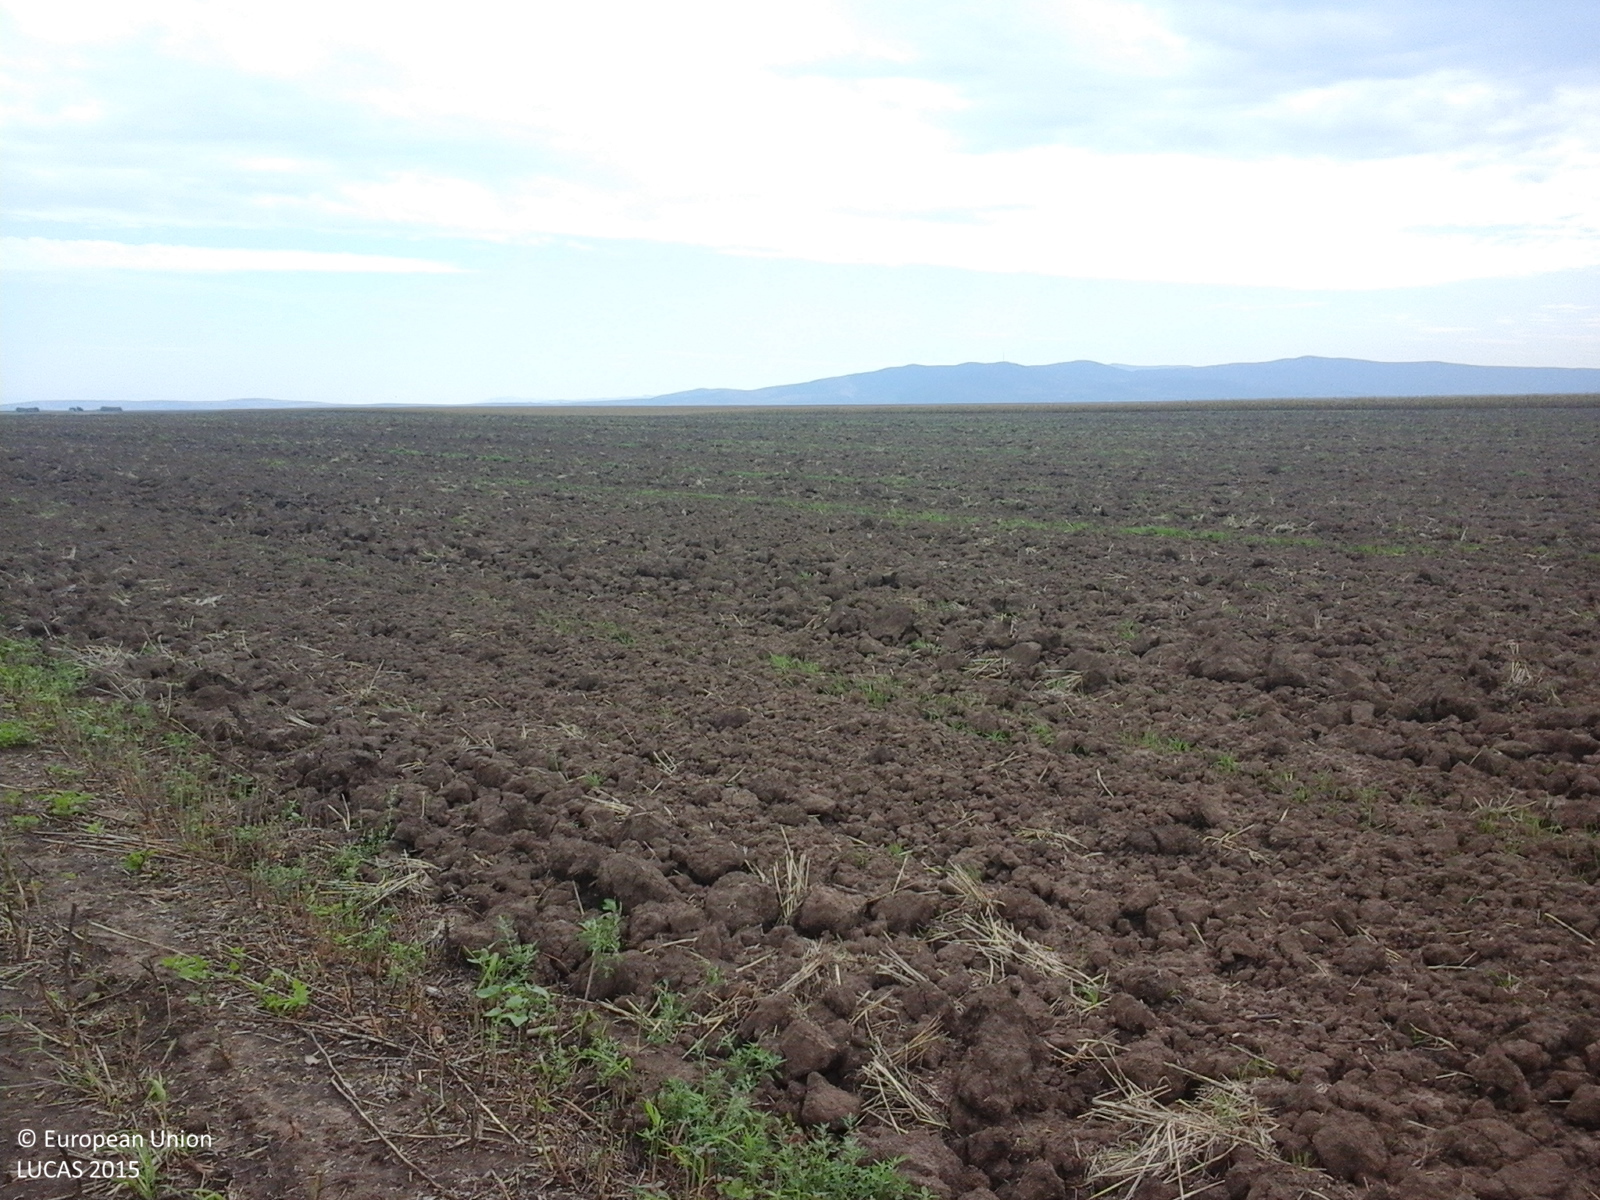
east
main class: Cropland
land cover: Maize
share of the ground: < 10 %
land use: Agriculture (excluding fallow land and kitchen gardens)
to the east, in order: Maize; Common wheat
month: August
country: RO
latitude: 46.3103
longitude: 21.5028
